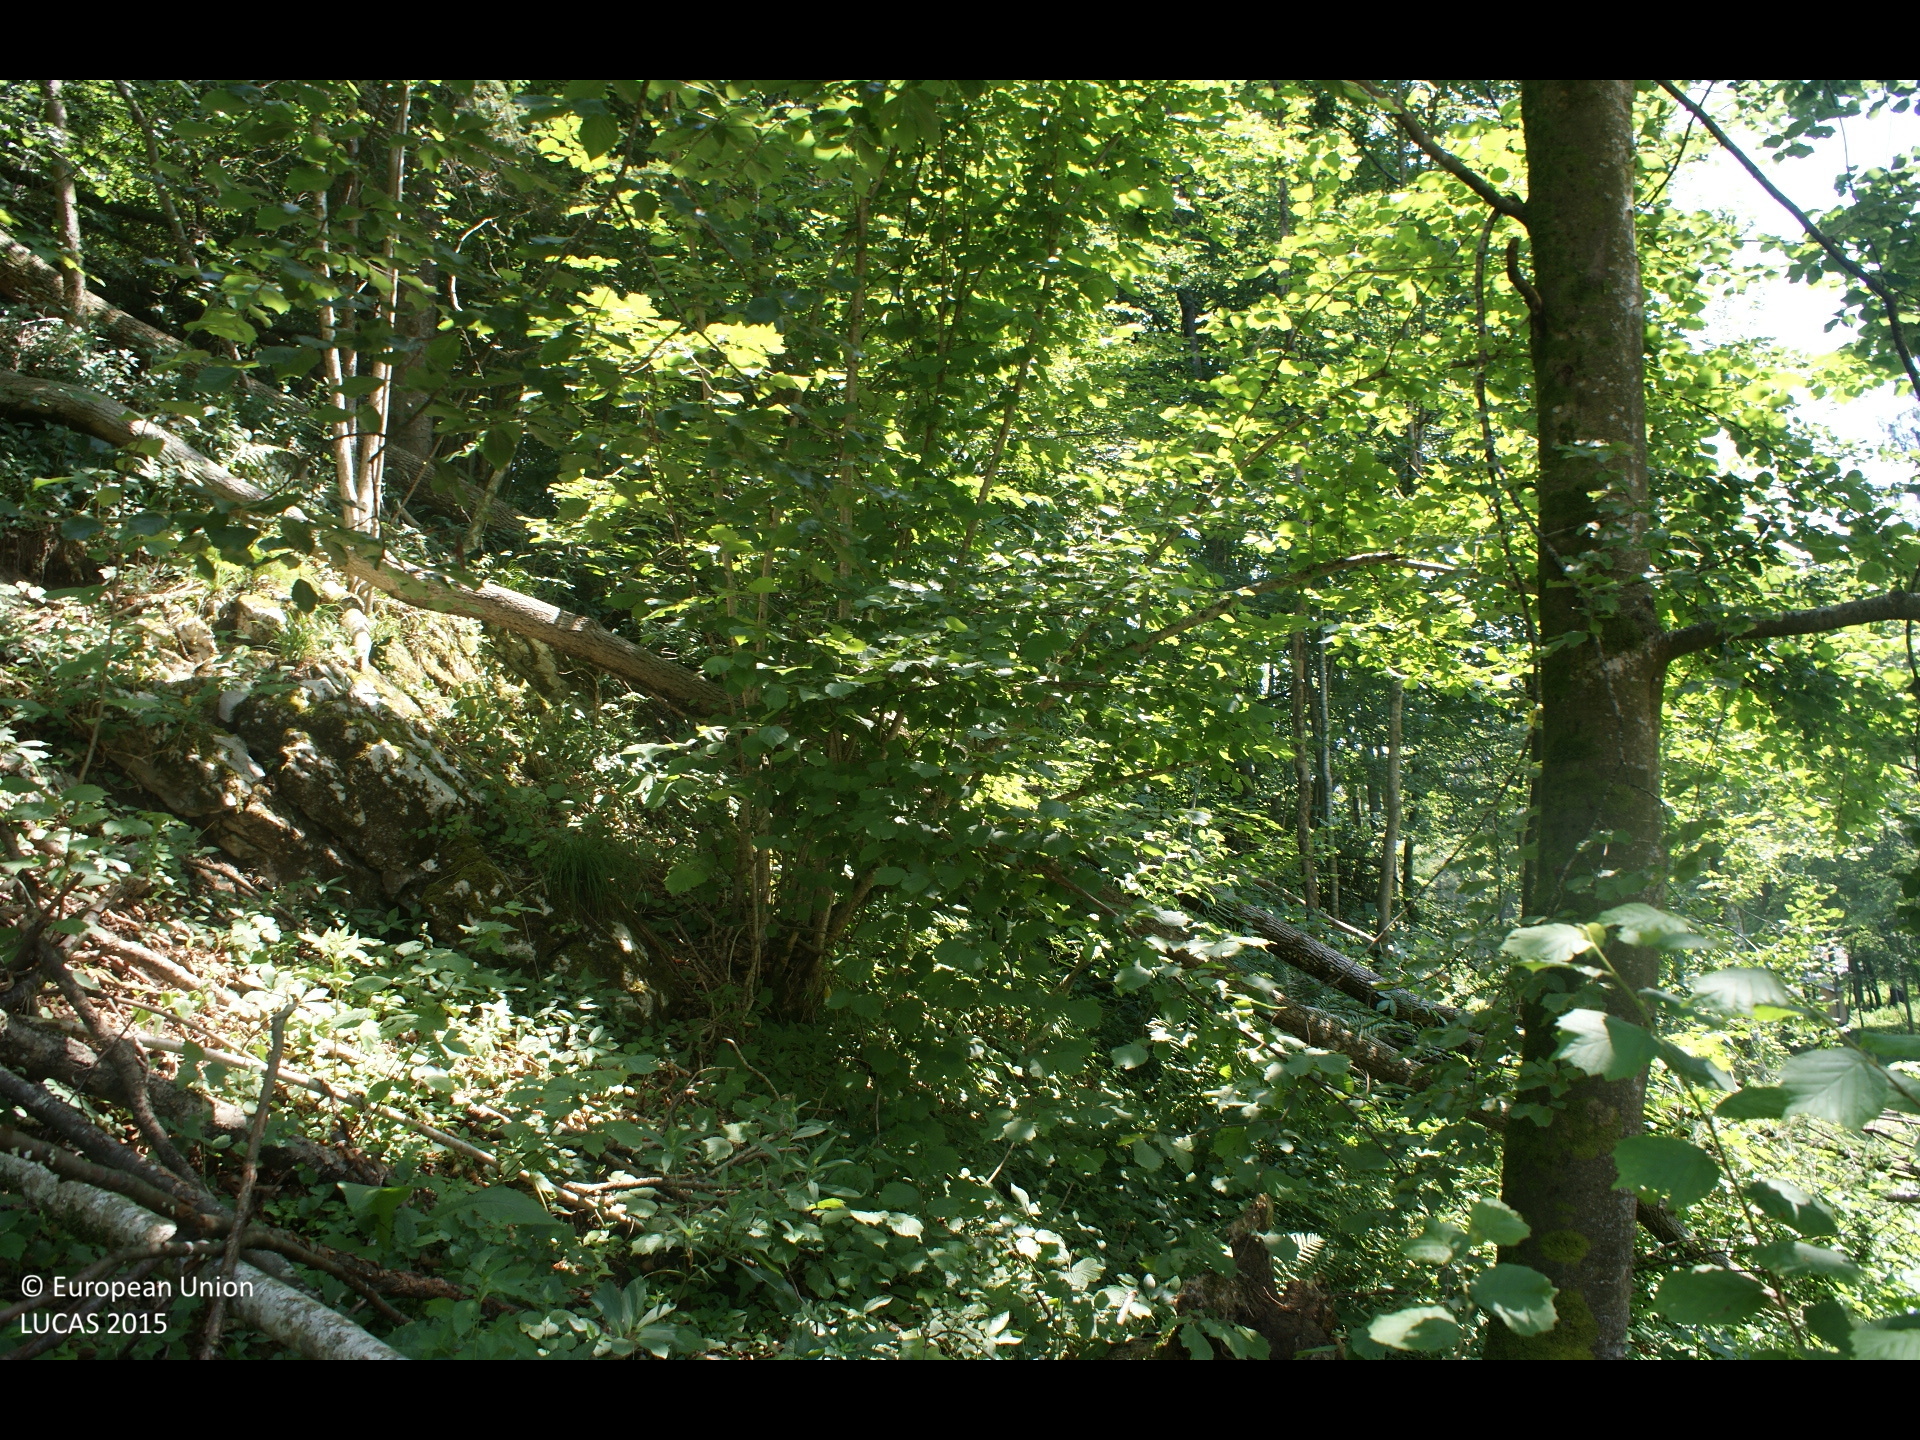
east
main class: Woodland
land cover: Other mixed woodland
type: mesophytic deciduous forest
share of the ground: > 75 %
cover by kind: broadleaved forest trees 50 %, coniferous forest trees 30 %, shrubs 20 %
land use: Forestry
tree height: > 5 m
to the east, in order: Other mixed woodland; Broadleaved woodland; Spruce dominated mixed woodland; Tracks; Spontaneously vegetated surfaces
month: July
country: AT
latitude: 47.9077
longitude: 14.2406
